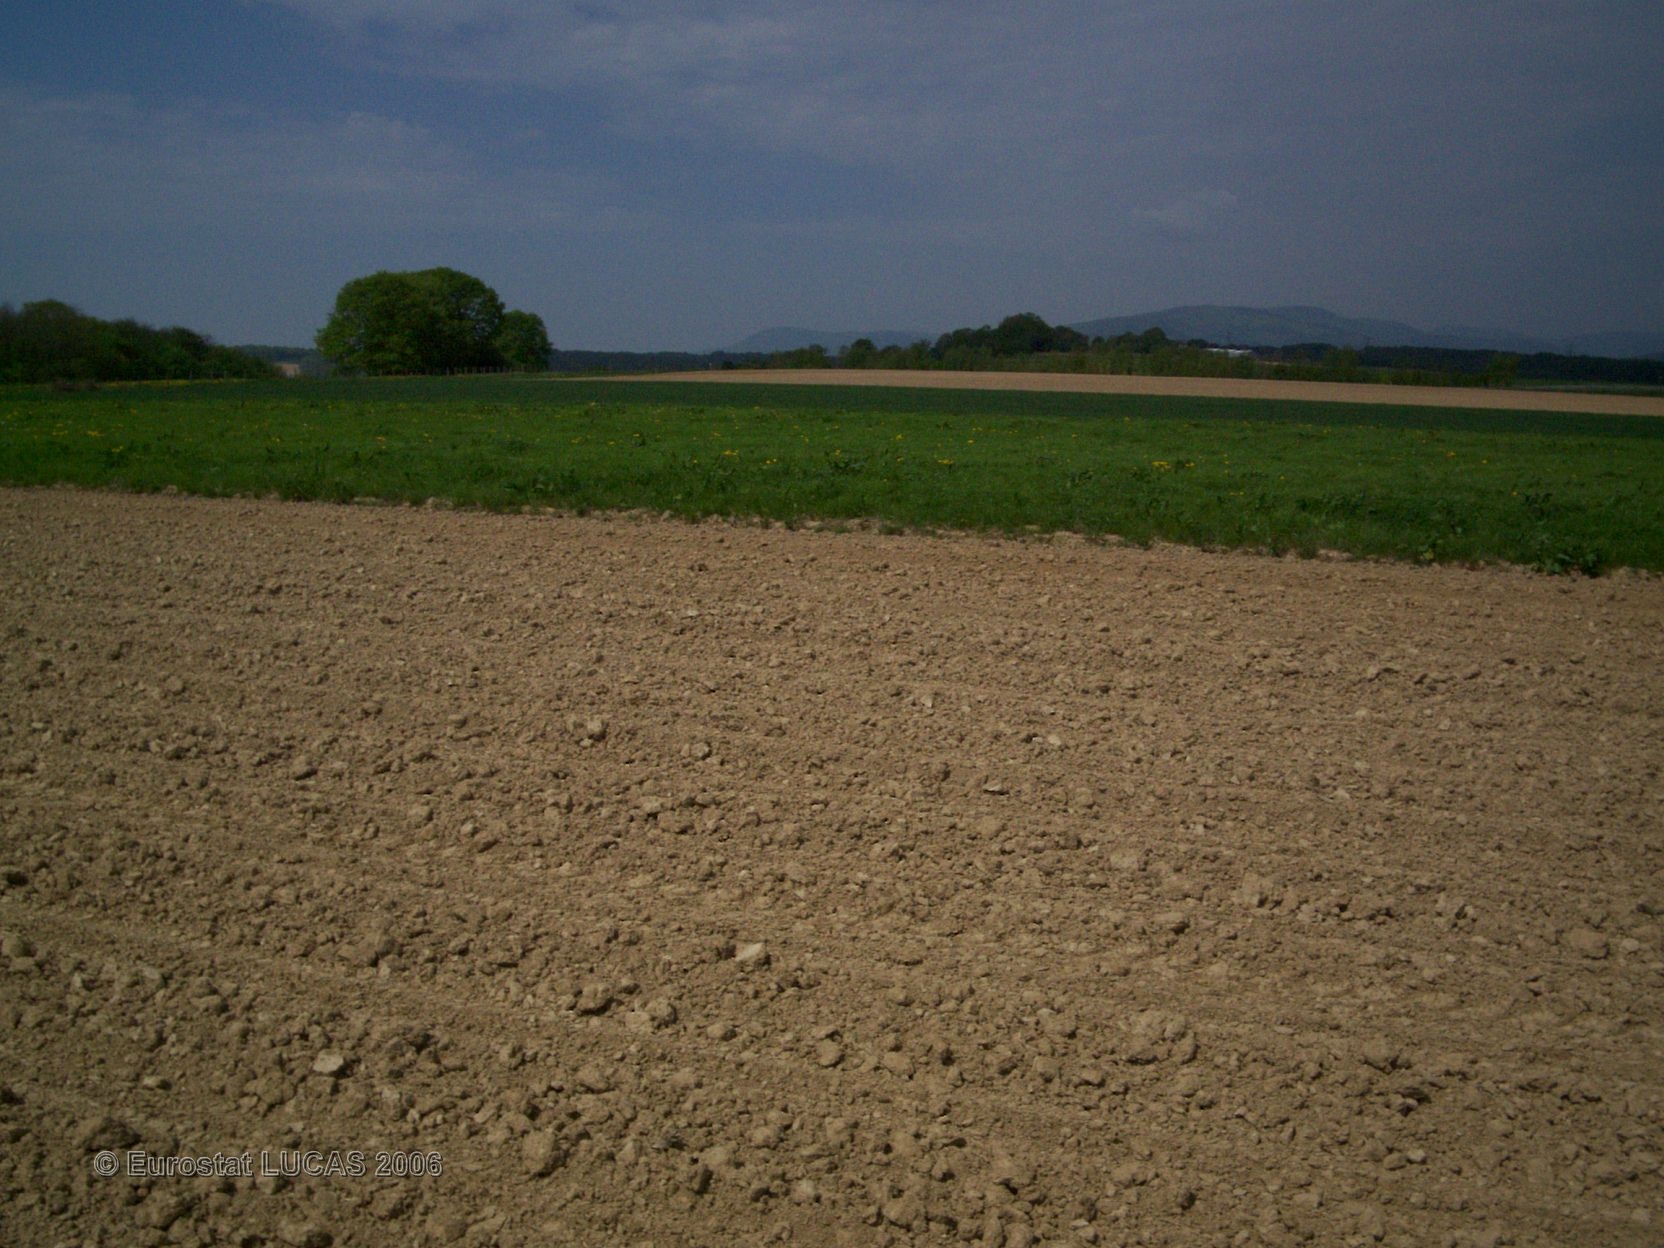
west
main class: Cropland
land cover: Maize
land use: Agriculture (excluding fallow land and kitchen gardens)
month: May
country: FR
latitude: 47.7174
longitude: 7.1088
